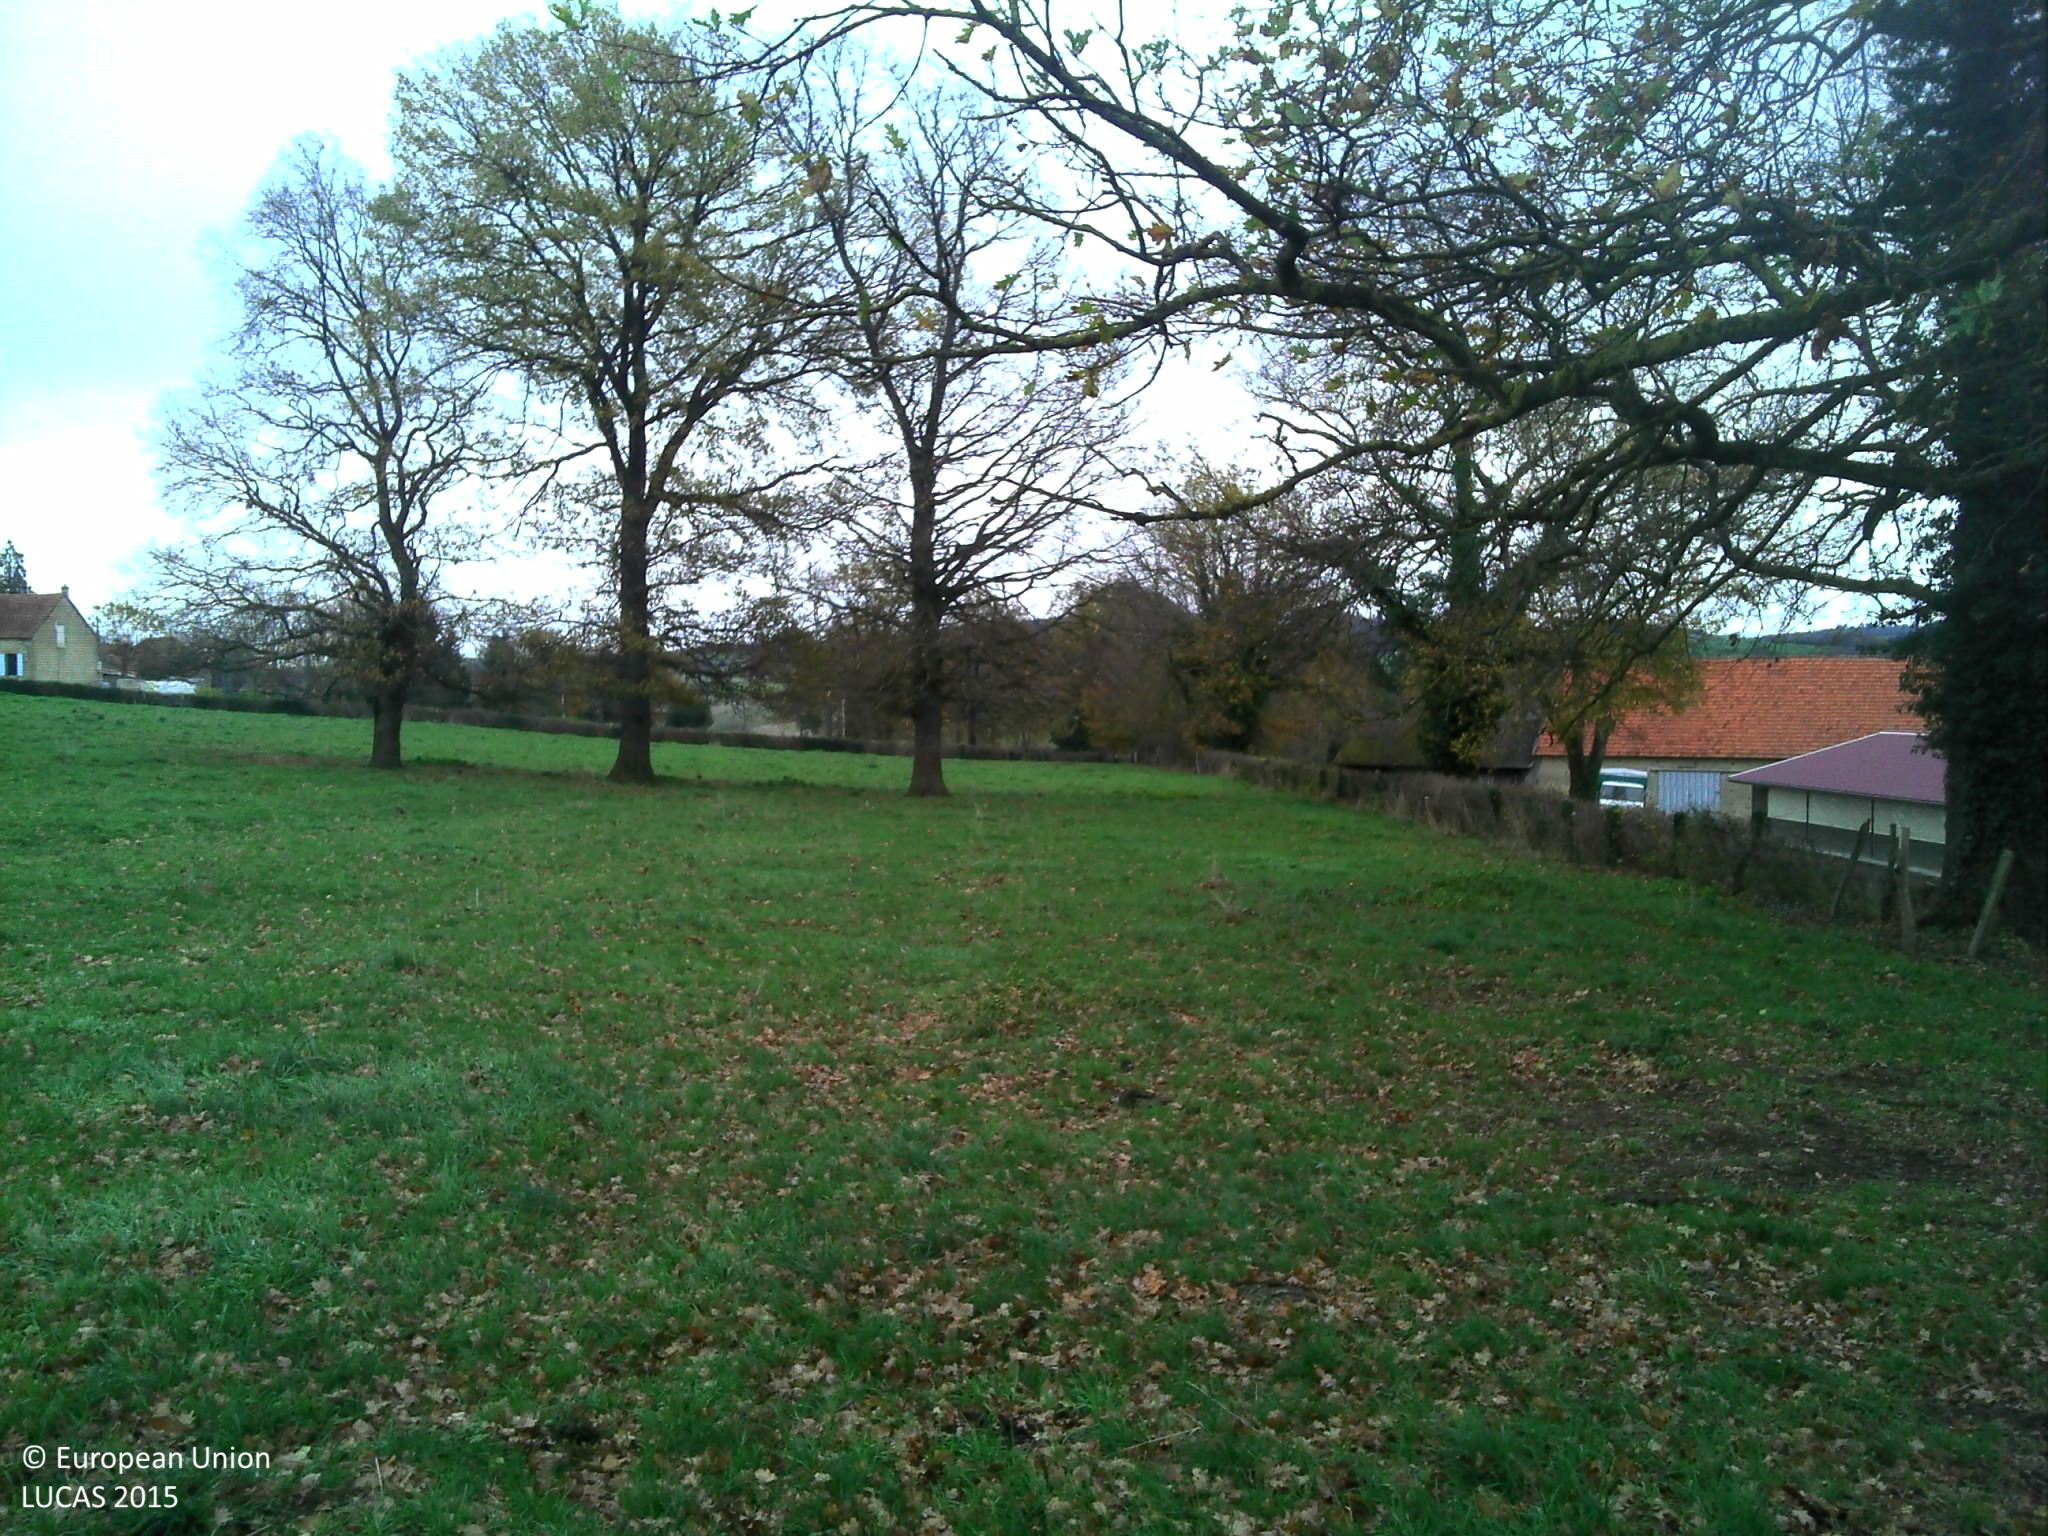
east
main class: Grassland
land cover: Grassland without tree/shrub cover
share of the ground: > 75 %
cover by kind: herbaceous plants 100 %
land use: Agriculture (excluding fallow land and kitchen gardens)
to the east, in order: Grassland without tree/shrub cover; Lines of trees; Grassland without tree/shrub cover; Fences; Abandoned hedges; Grass margins; Electric lines; Grass margins; Ditches and canals; Grass margins; Paved roads, cycling and walking lanes; Grass margins; Ditches and canals; Grass margins; Managed hedges; Fences; Grassland without tree/shrub cover; Grassland with sparse tree/shrub cover; Fences; Managed hedges; Fences; Grassland without tree/shrub cover
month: November
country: FR
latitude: 46.3280
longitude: 3.7001
